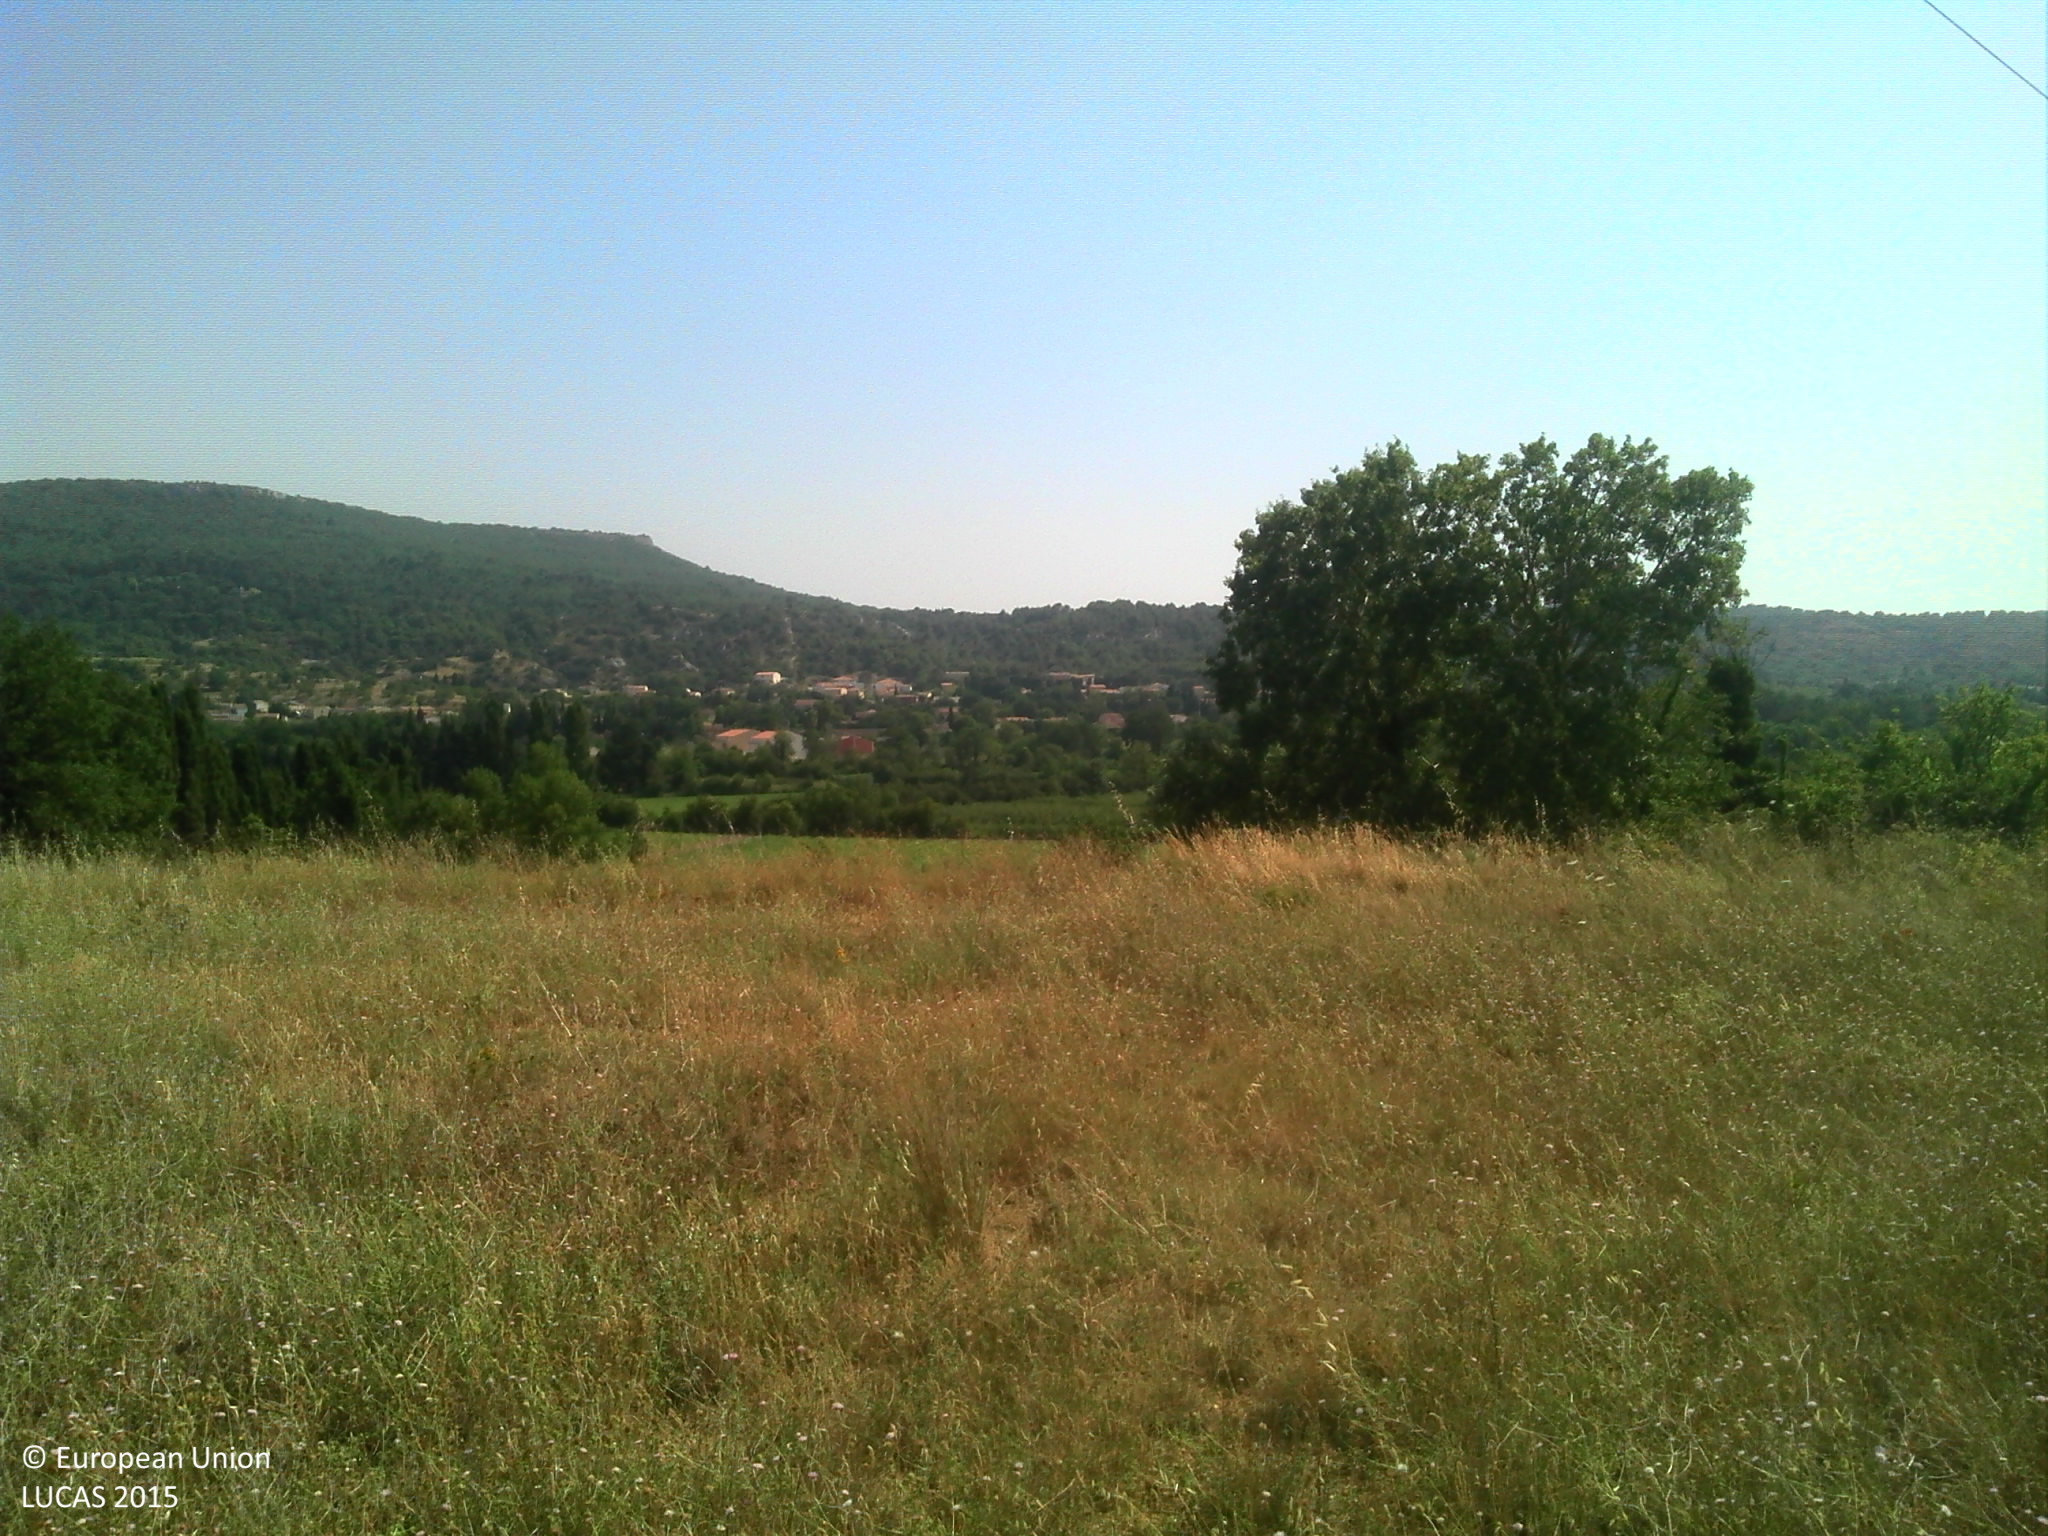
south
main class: Grassland
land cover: Grassland without tree/shrub cover
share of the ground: > 75 %
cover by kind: herbaceous plants 100 %
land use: Agriculture (excluding fallow land and kitchen gardens)
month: July
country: FR
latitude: 43.7135
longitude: 5.1564
